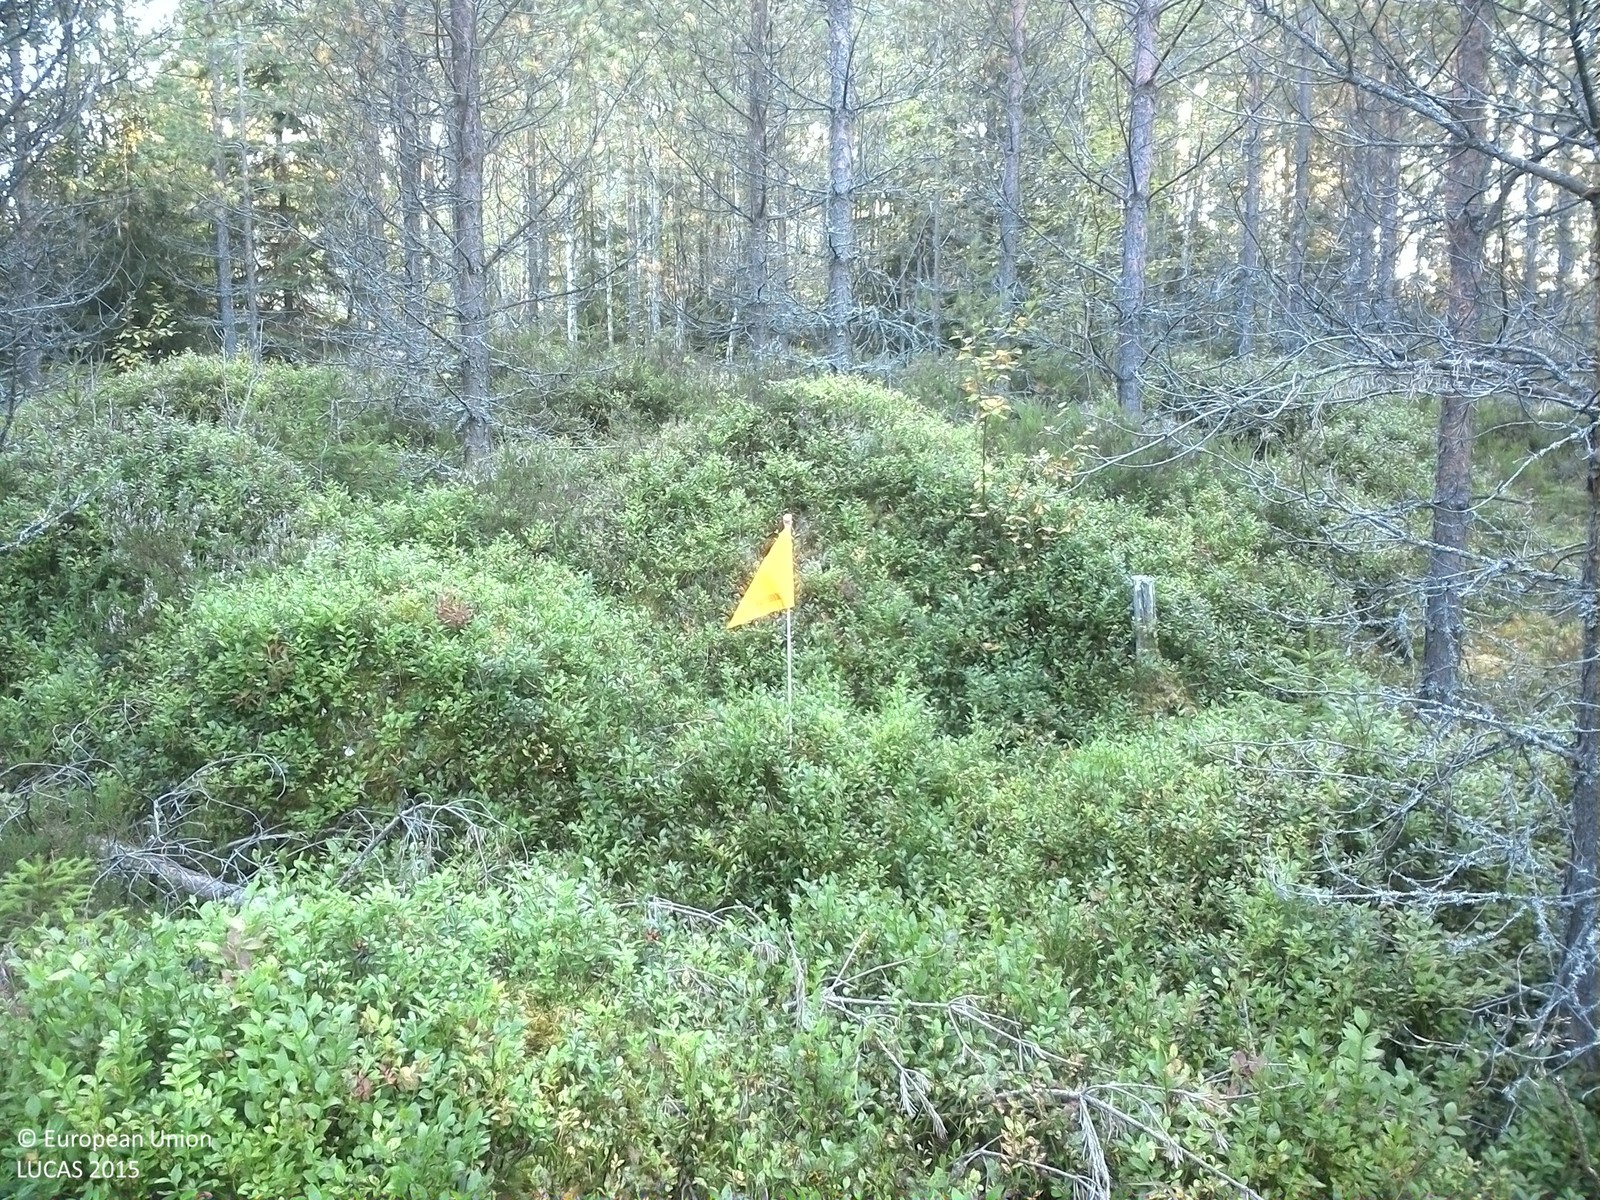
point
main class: Woodland
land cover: Pine dominated coniferous woodland
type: boreal forest
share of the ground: > 75 %
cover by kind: coniferous forest trees 75 %, shrubs 20 %, lichens and mosses 5 %
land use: Forestry
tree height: > 5 m
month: September
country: SE
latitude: 61.7433
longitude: 15.2660
